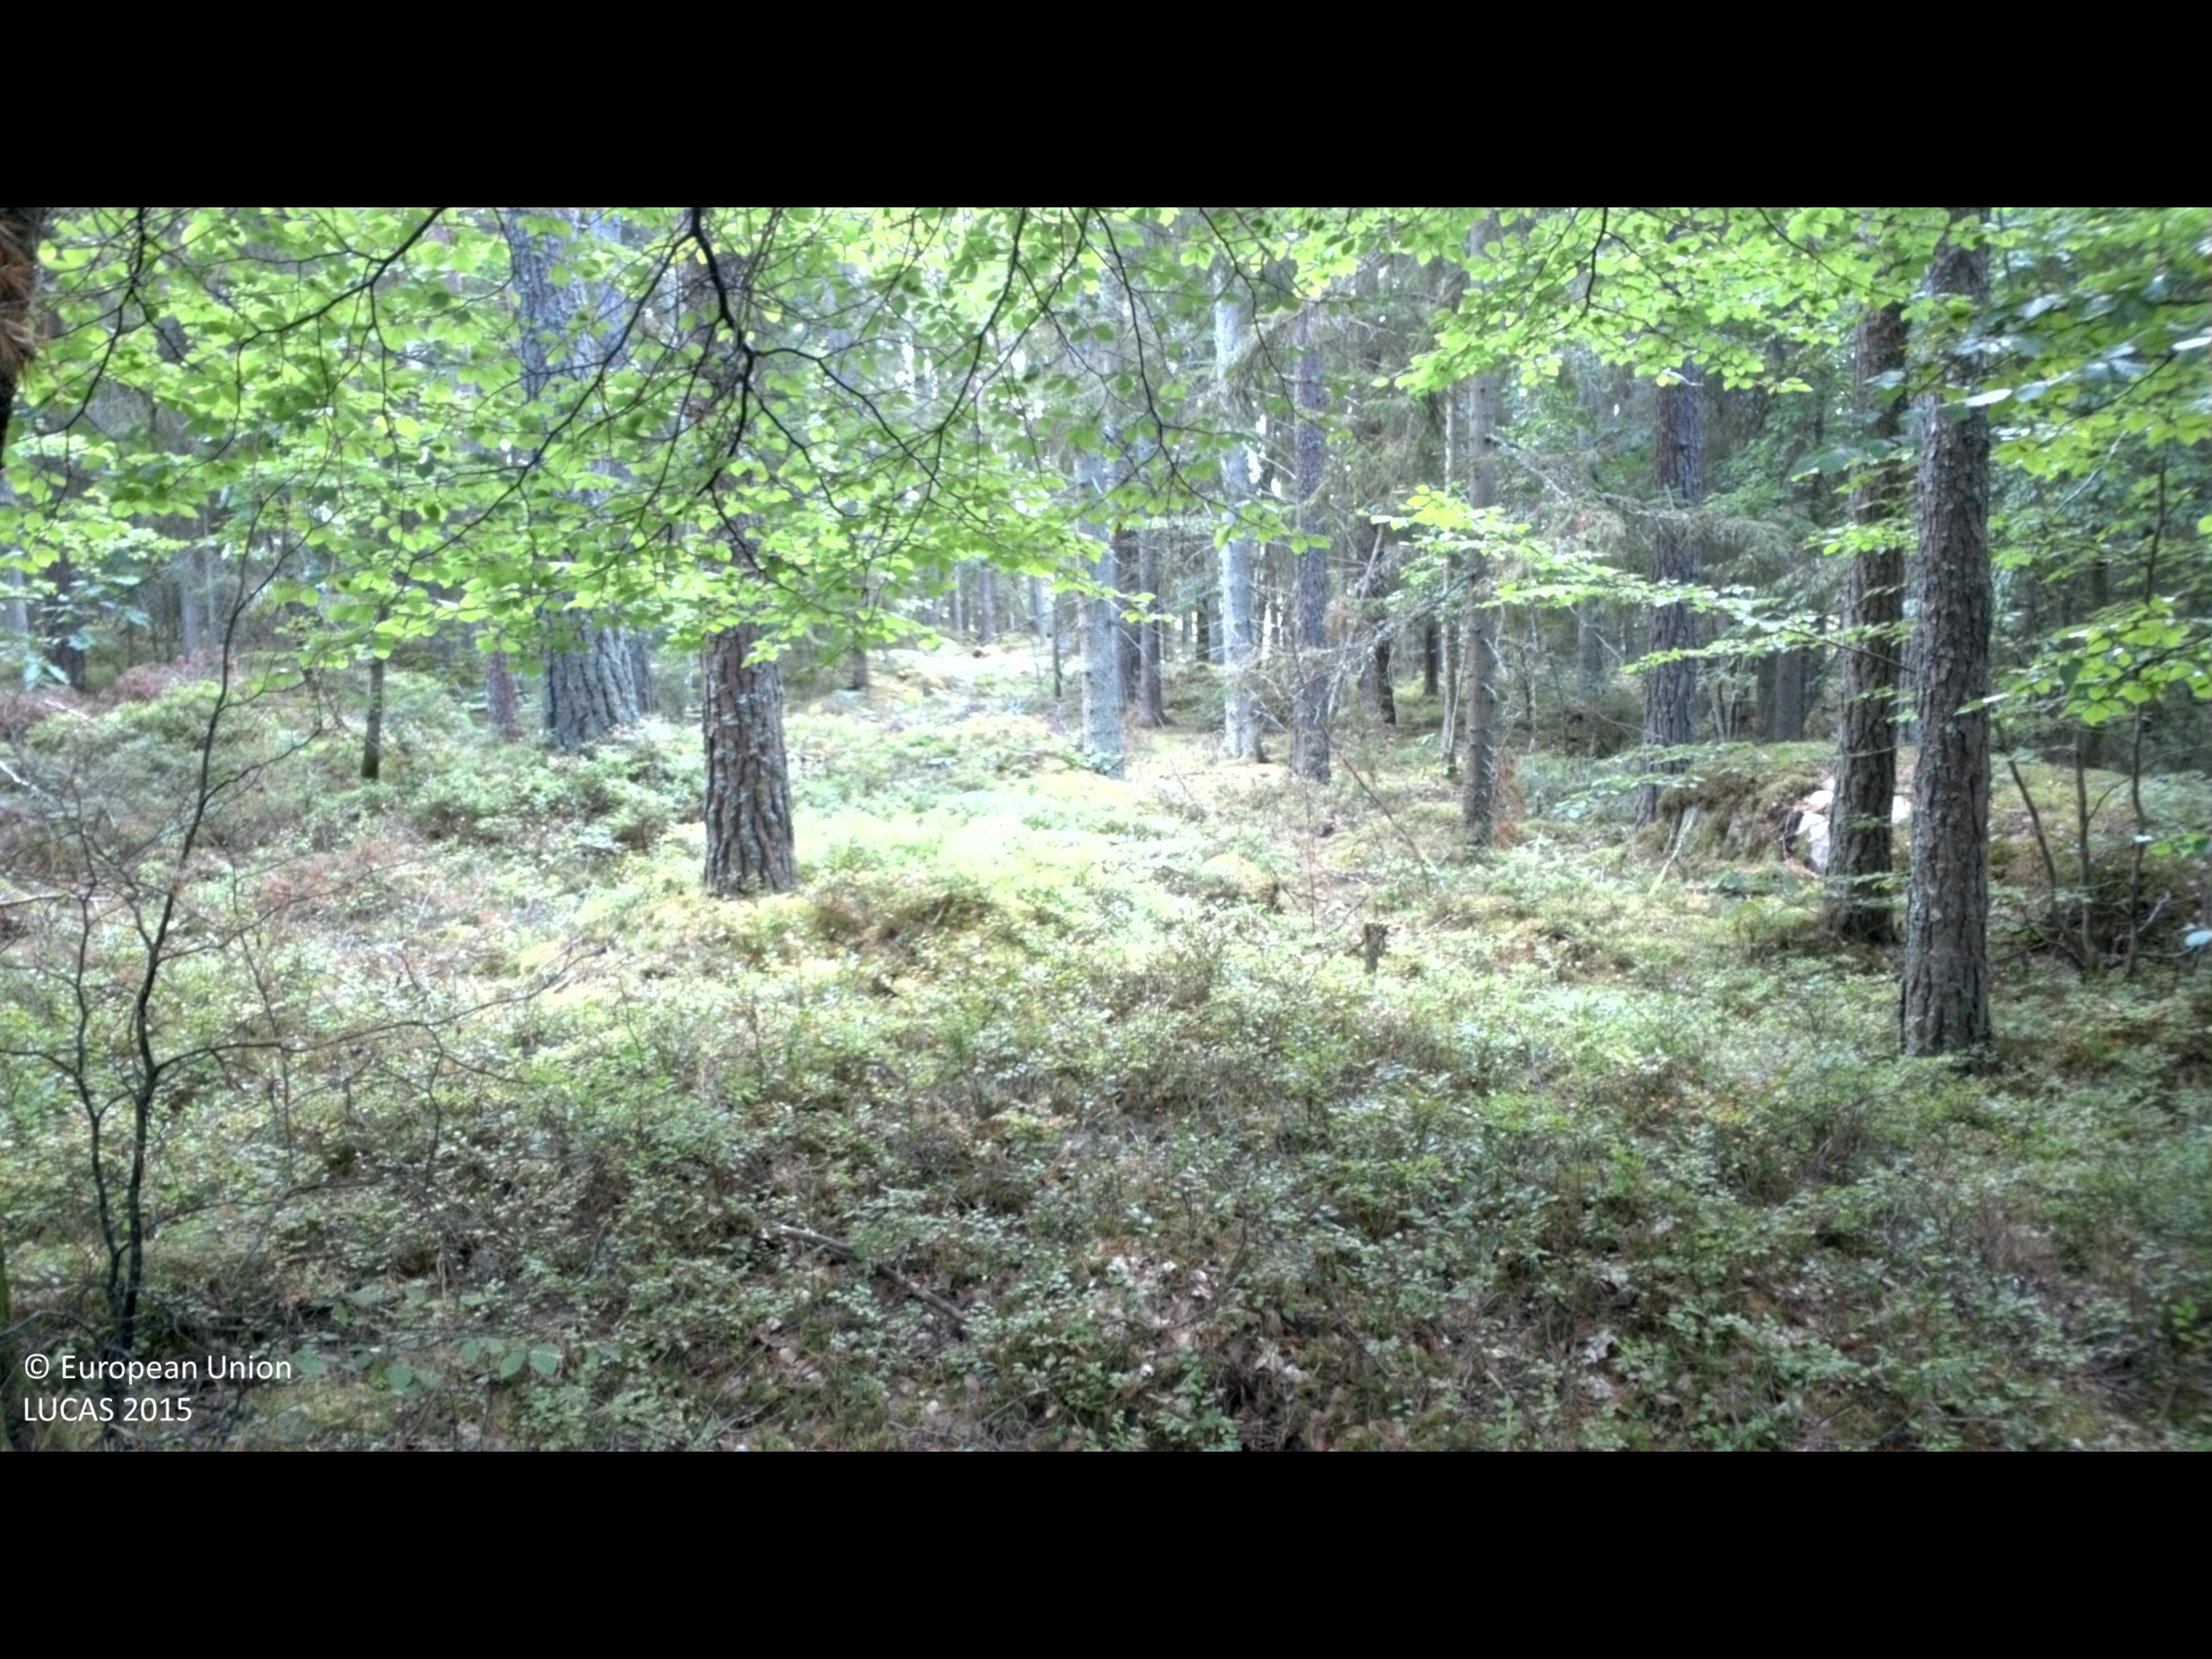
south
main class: Woodland
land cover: Pine dominated mixed woodland
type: hemiboreal forest and nemoral coniferous forest and mixed broadleaved-coniferous forest
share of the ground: 50 - 75 %
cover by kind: coniferous forest trees 50 %, broadleaved forest trees 20 %, shrubs 20 %, lichens and mosses 10 %
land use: Forestry
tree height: > 5 m
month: September
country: SE
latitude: 56.2877
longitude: 15.0228
